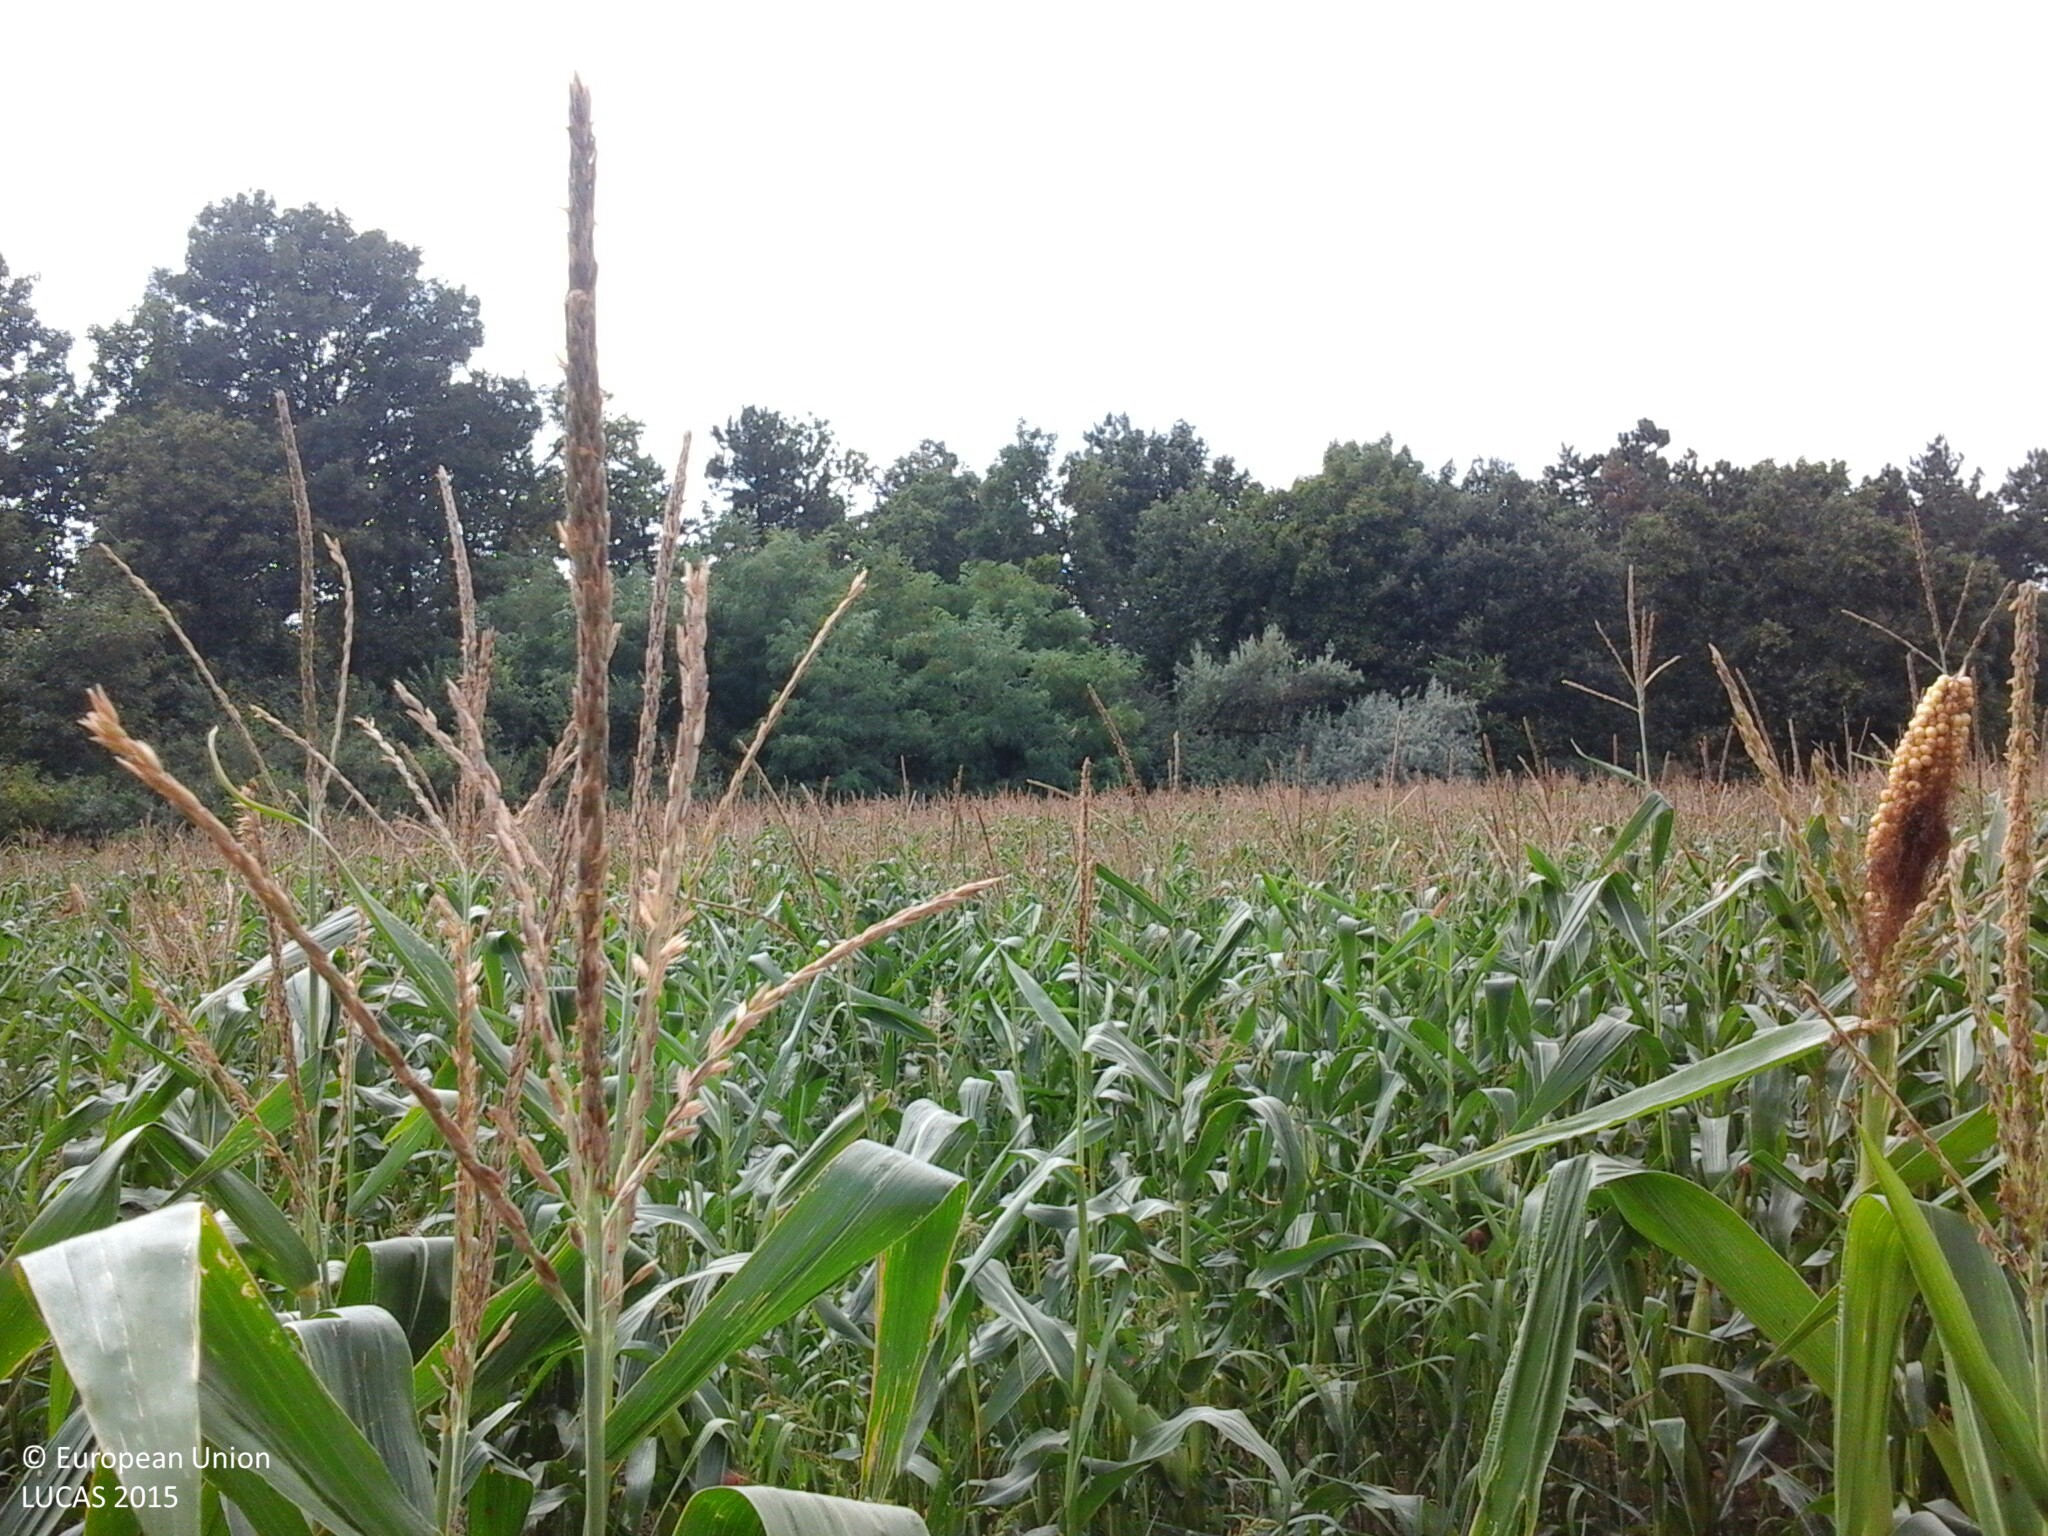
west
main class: Cropland
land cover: Maize
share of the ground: > 75 %
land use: Agriculture (excluding fallow land and kitchen gardens)
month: August
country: HU
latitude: 47.0347
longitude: 18.1560
